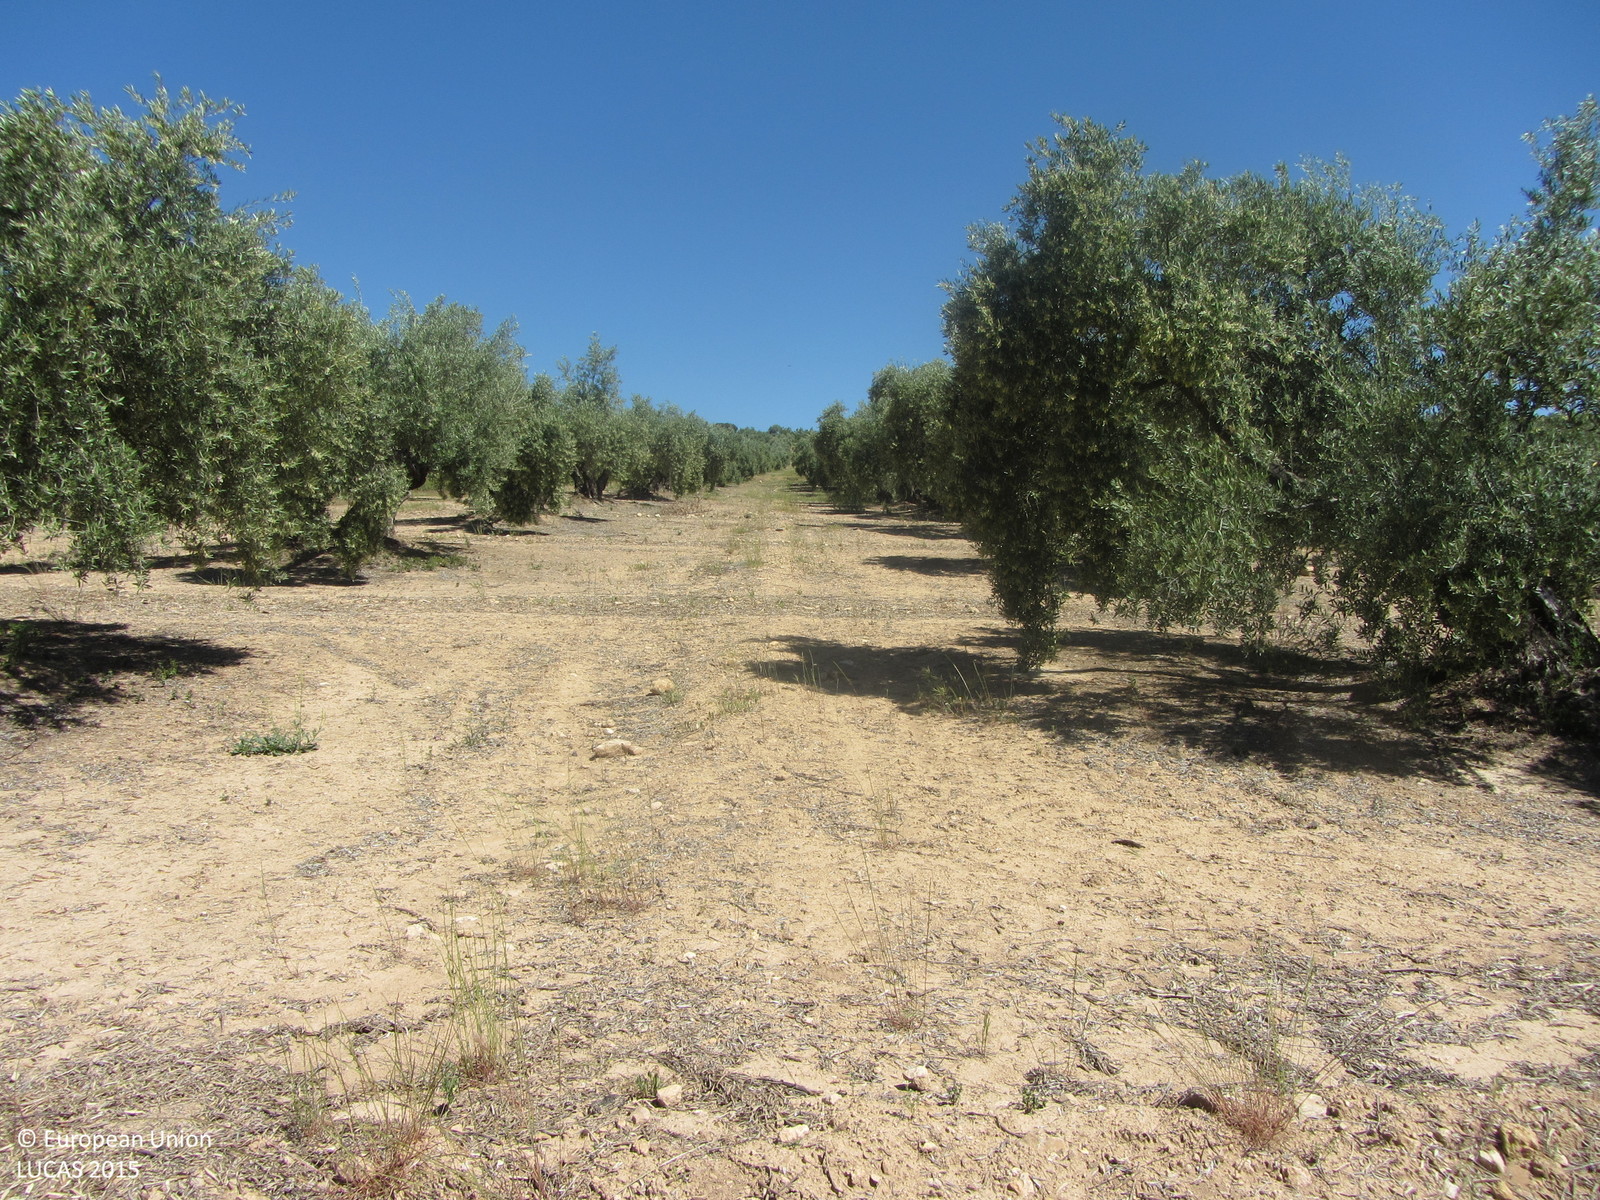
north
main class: Cropland
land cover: Olive groves
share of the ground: 25 - 50 %
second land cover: Other bare soil
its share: > 75 %
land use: Agriculture (excluding fallow land and kitchen gardens)
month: May
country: ES
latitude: 38.2513
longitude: -3.0848
